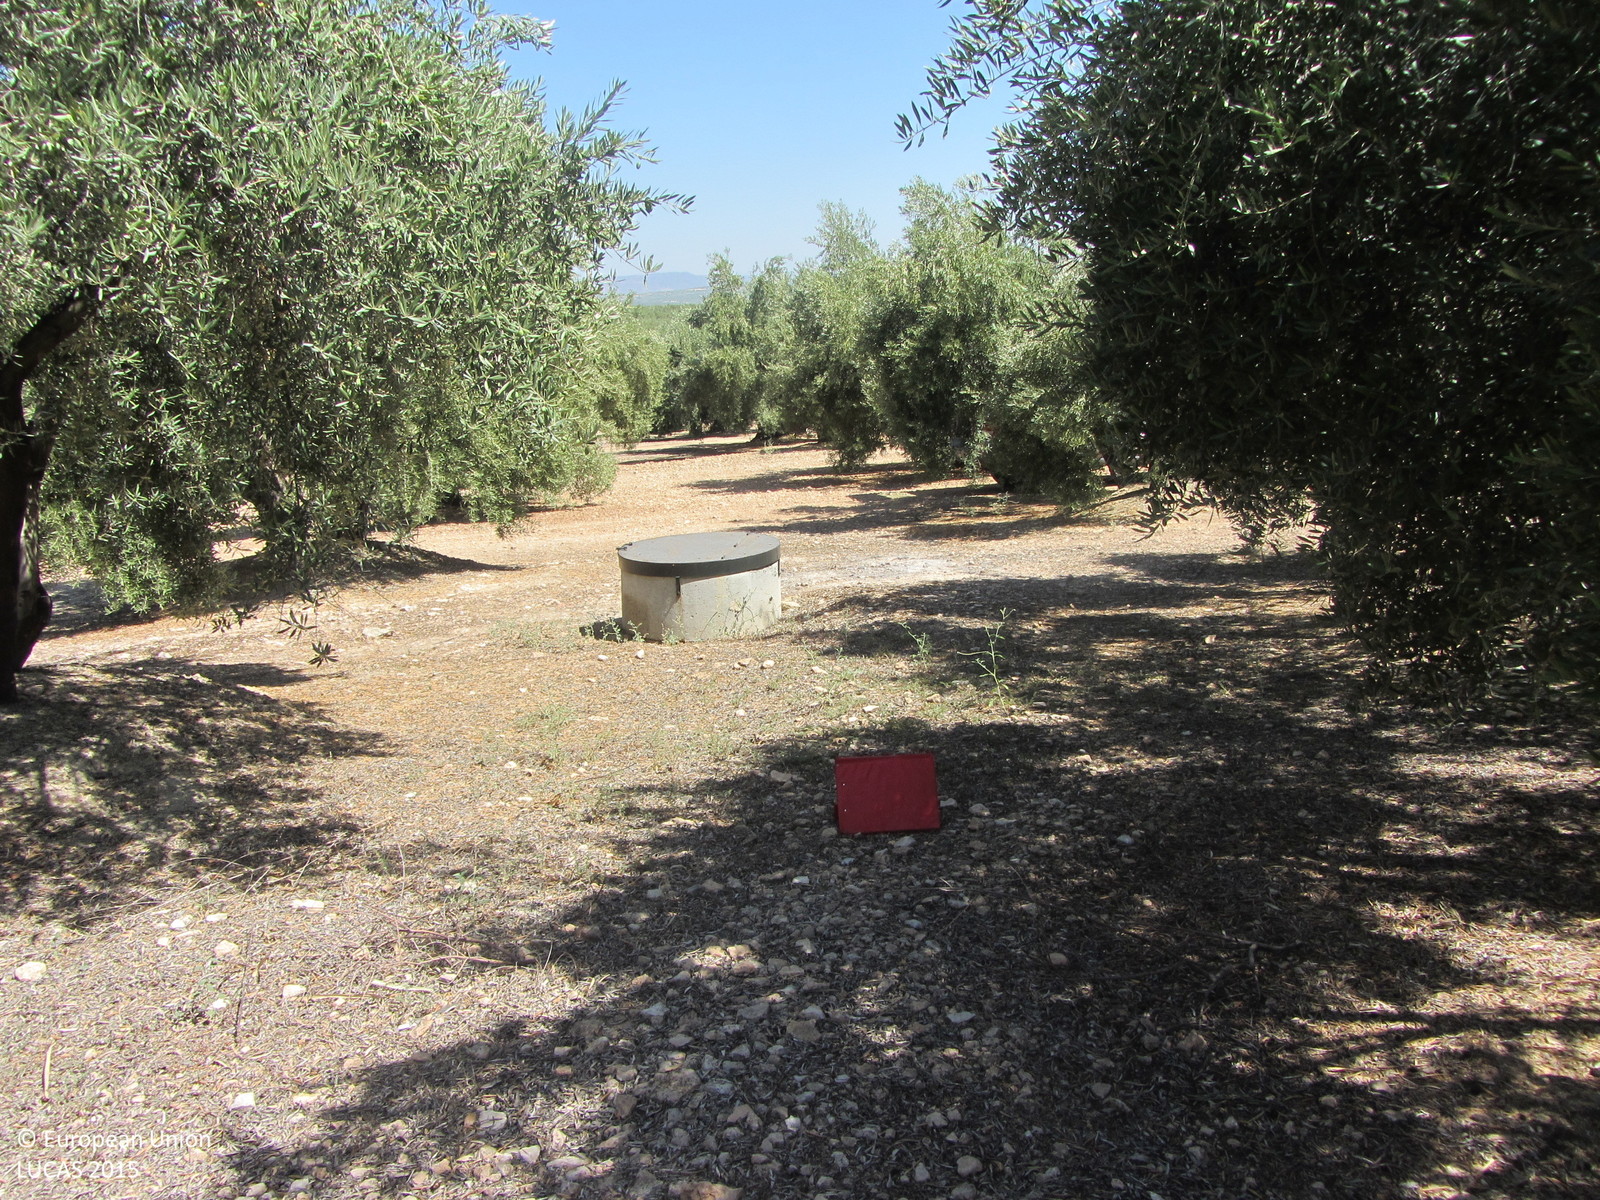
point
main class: Cropland
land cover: Olive groves
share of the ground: 50 - 75 %
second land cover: Other bare soil
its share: > 75 %
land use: Agriculture (excluding fallow land and kitchen gardens)
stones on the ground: 10 - 25 %
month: July
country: ES
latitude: 37.9827
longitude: -3.8145
